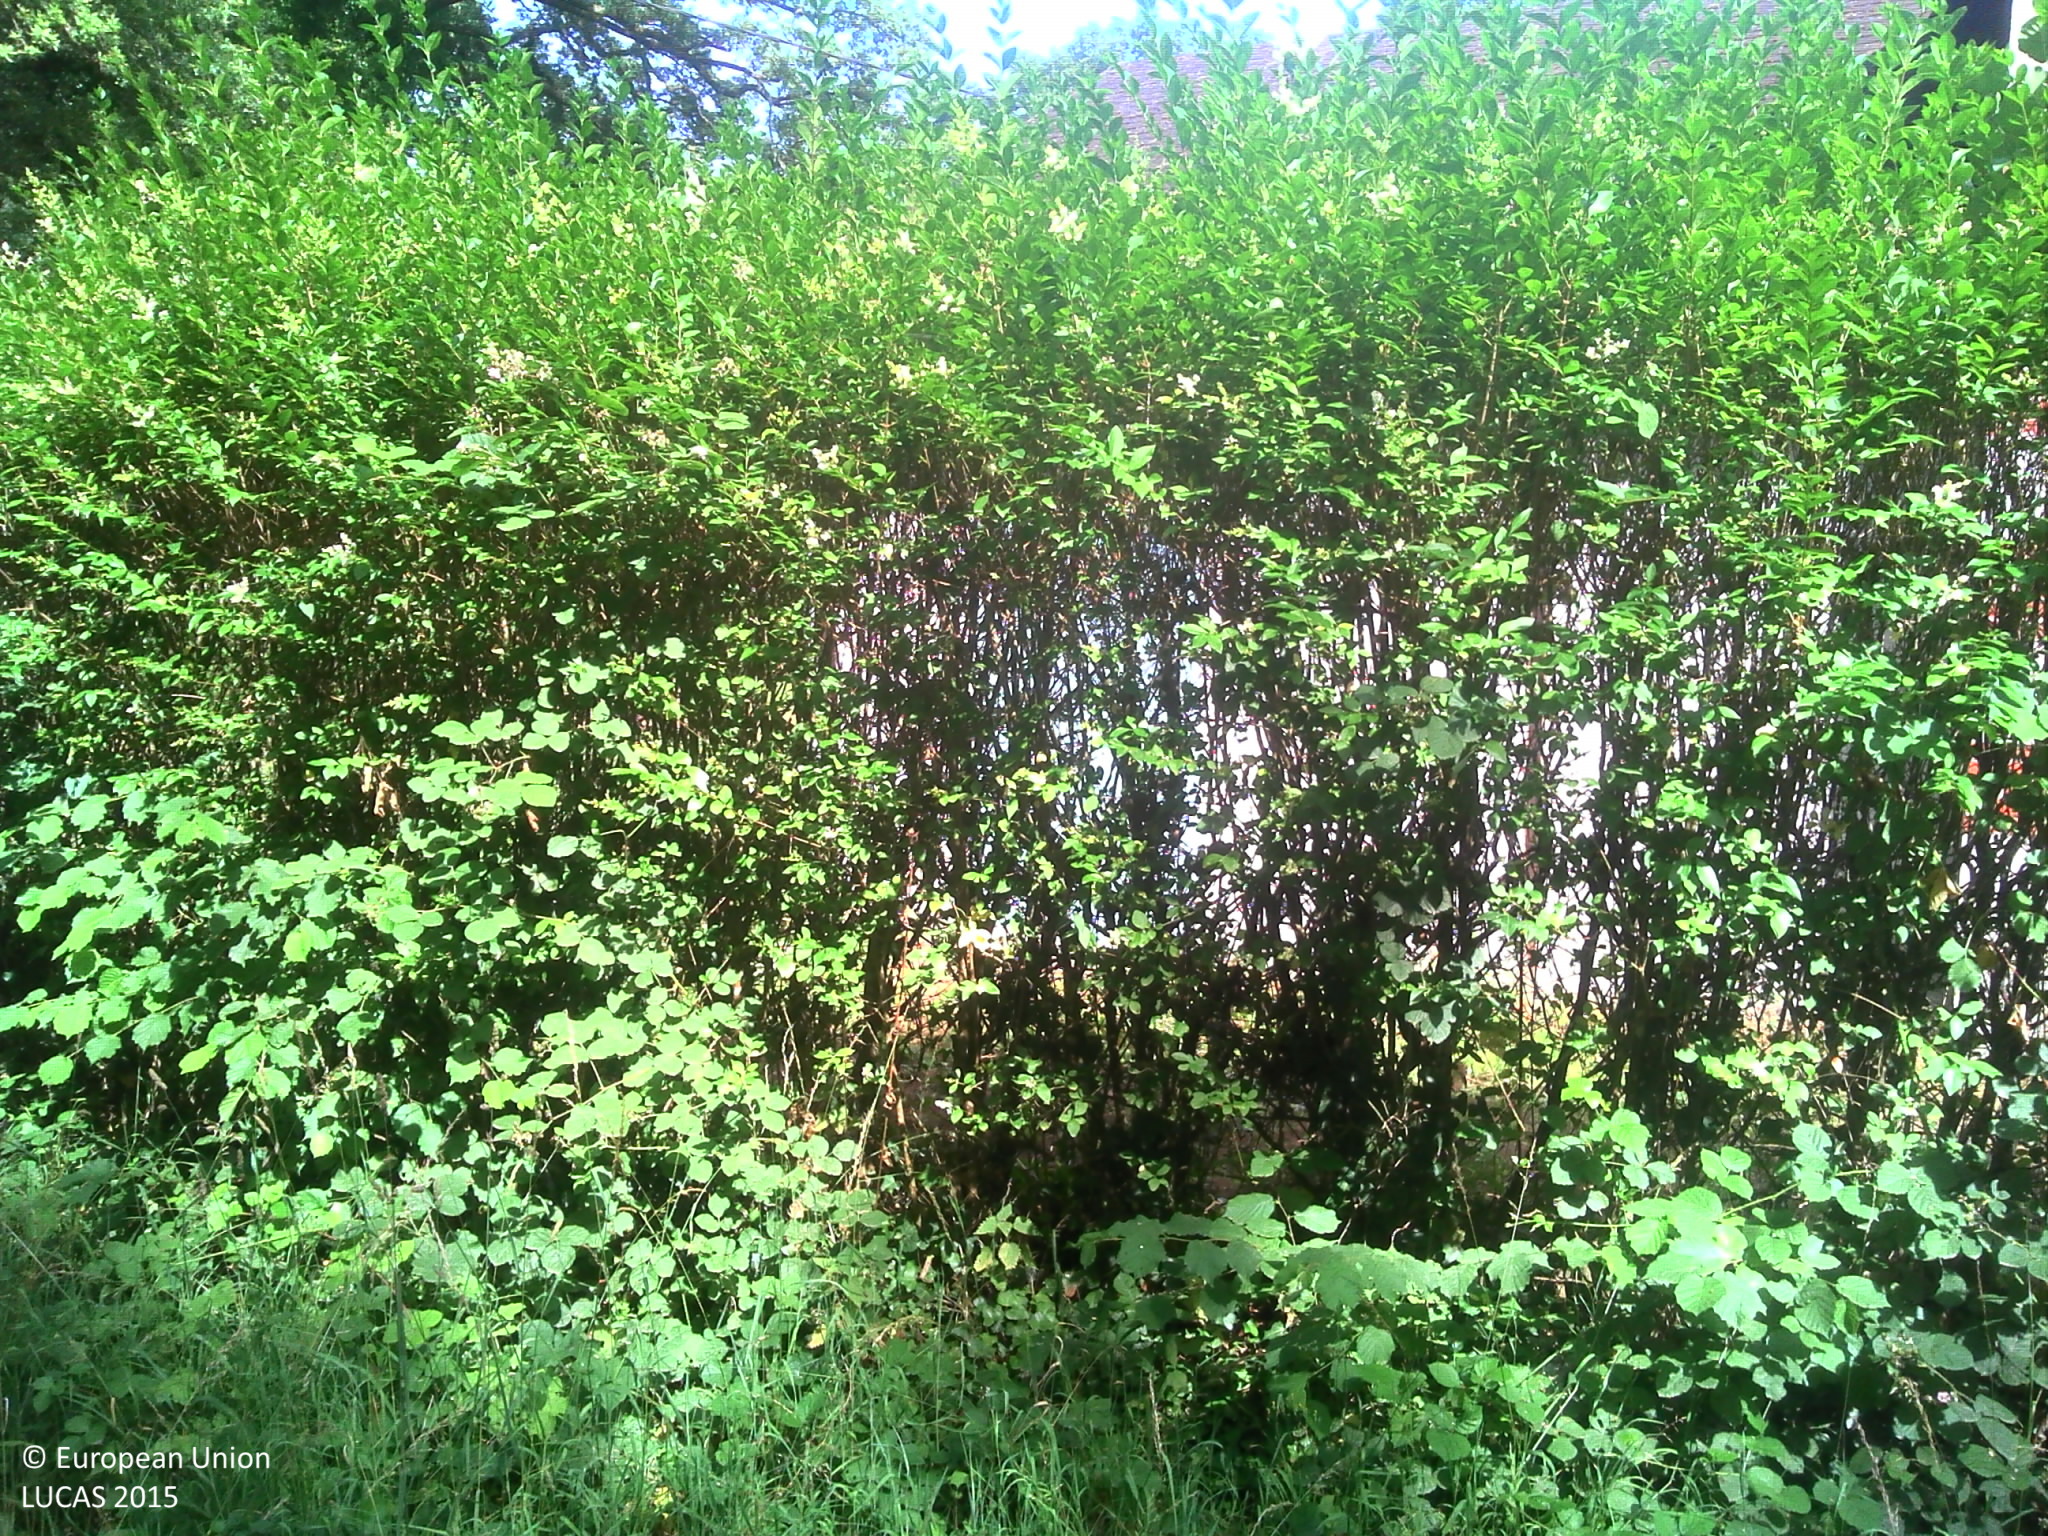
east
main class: Grassland
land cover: Grassland with sparse tree/shrub cover
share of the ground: > 75 %
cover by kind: herbaceous plants 95 %, broadleaved forest trees 5 %
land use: Residential
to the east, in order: Grassland with sparse tree/shrub cover; Broadleaved woodland; Grassland without tree/shrub cover; Broadleaved woodland
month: June
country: FR
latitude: 47.4331
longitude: 1.3809
